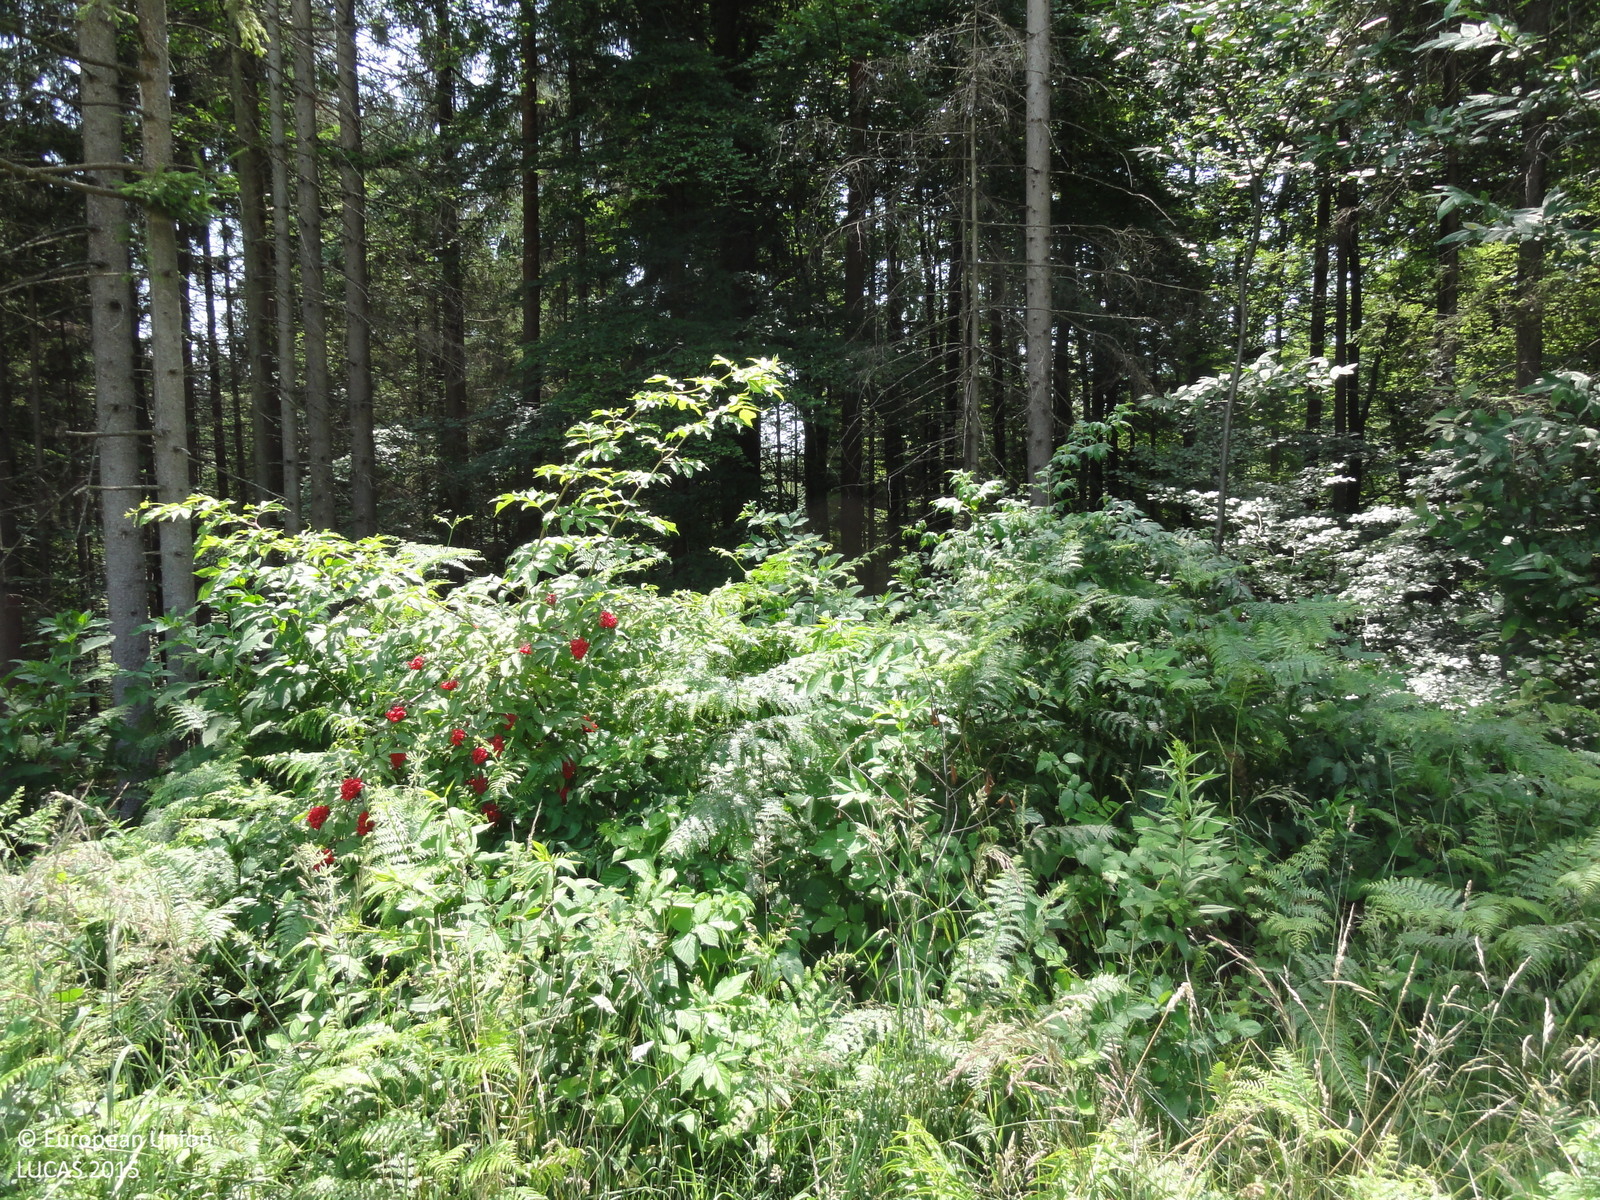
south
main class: Grassland
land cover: Grassland without tree/shrub cover
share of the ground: > 75 %
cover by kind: herbaceous plants 100 %
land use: Agriculture (excluding fallow land and kitchen gardens)
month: July
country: SI
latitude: 46.3351
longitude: 15.5195
